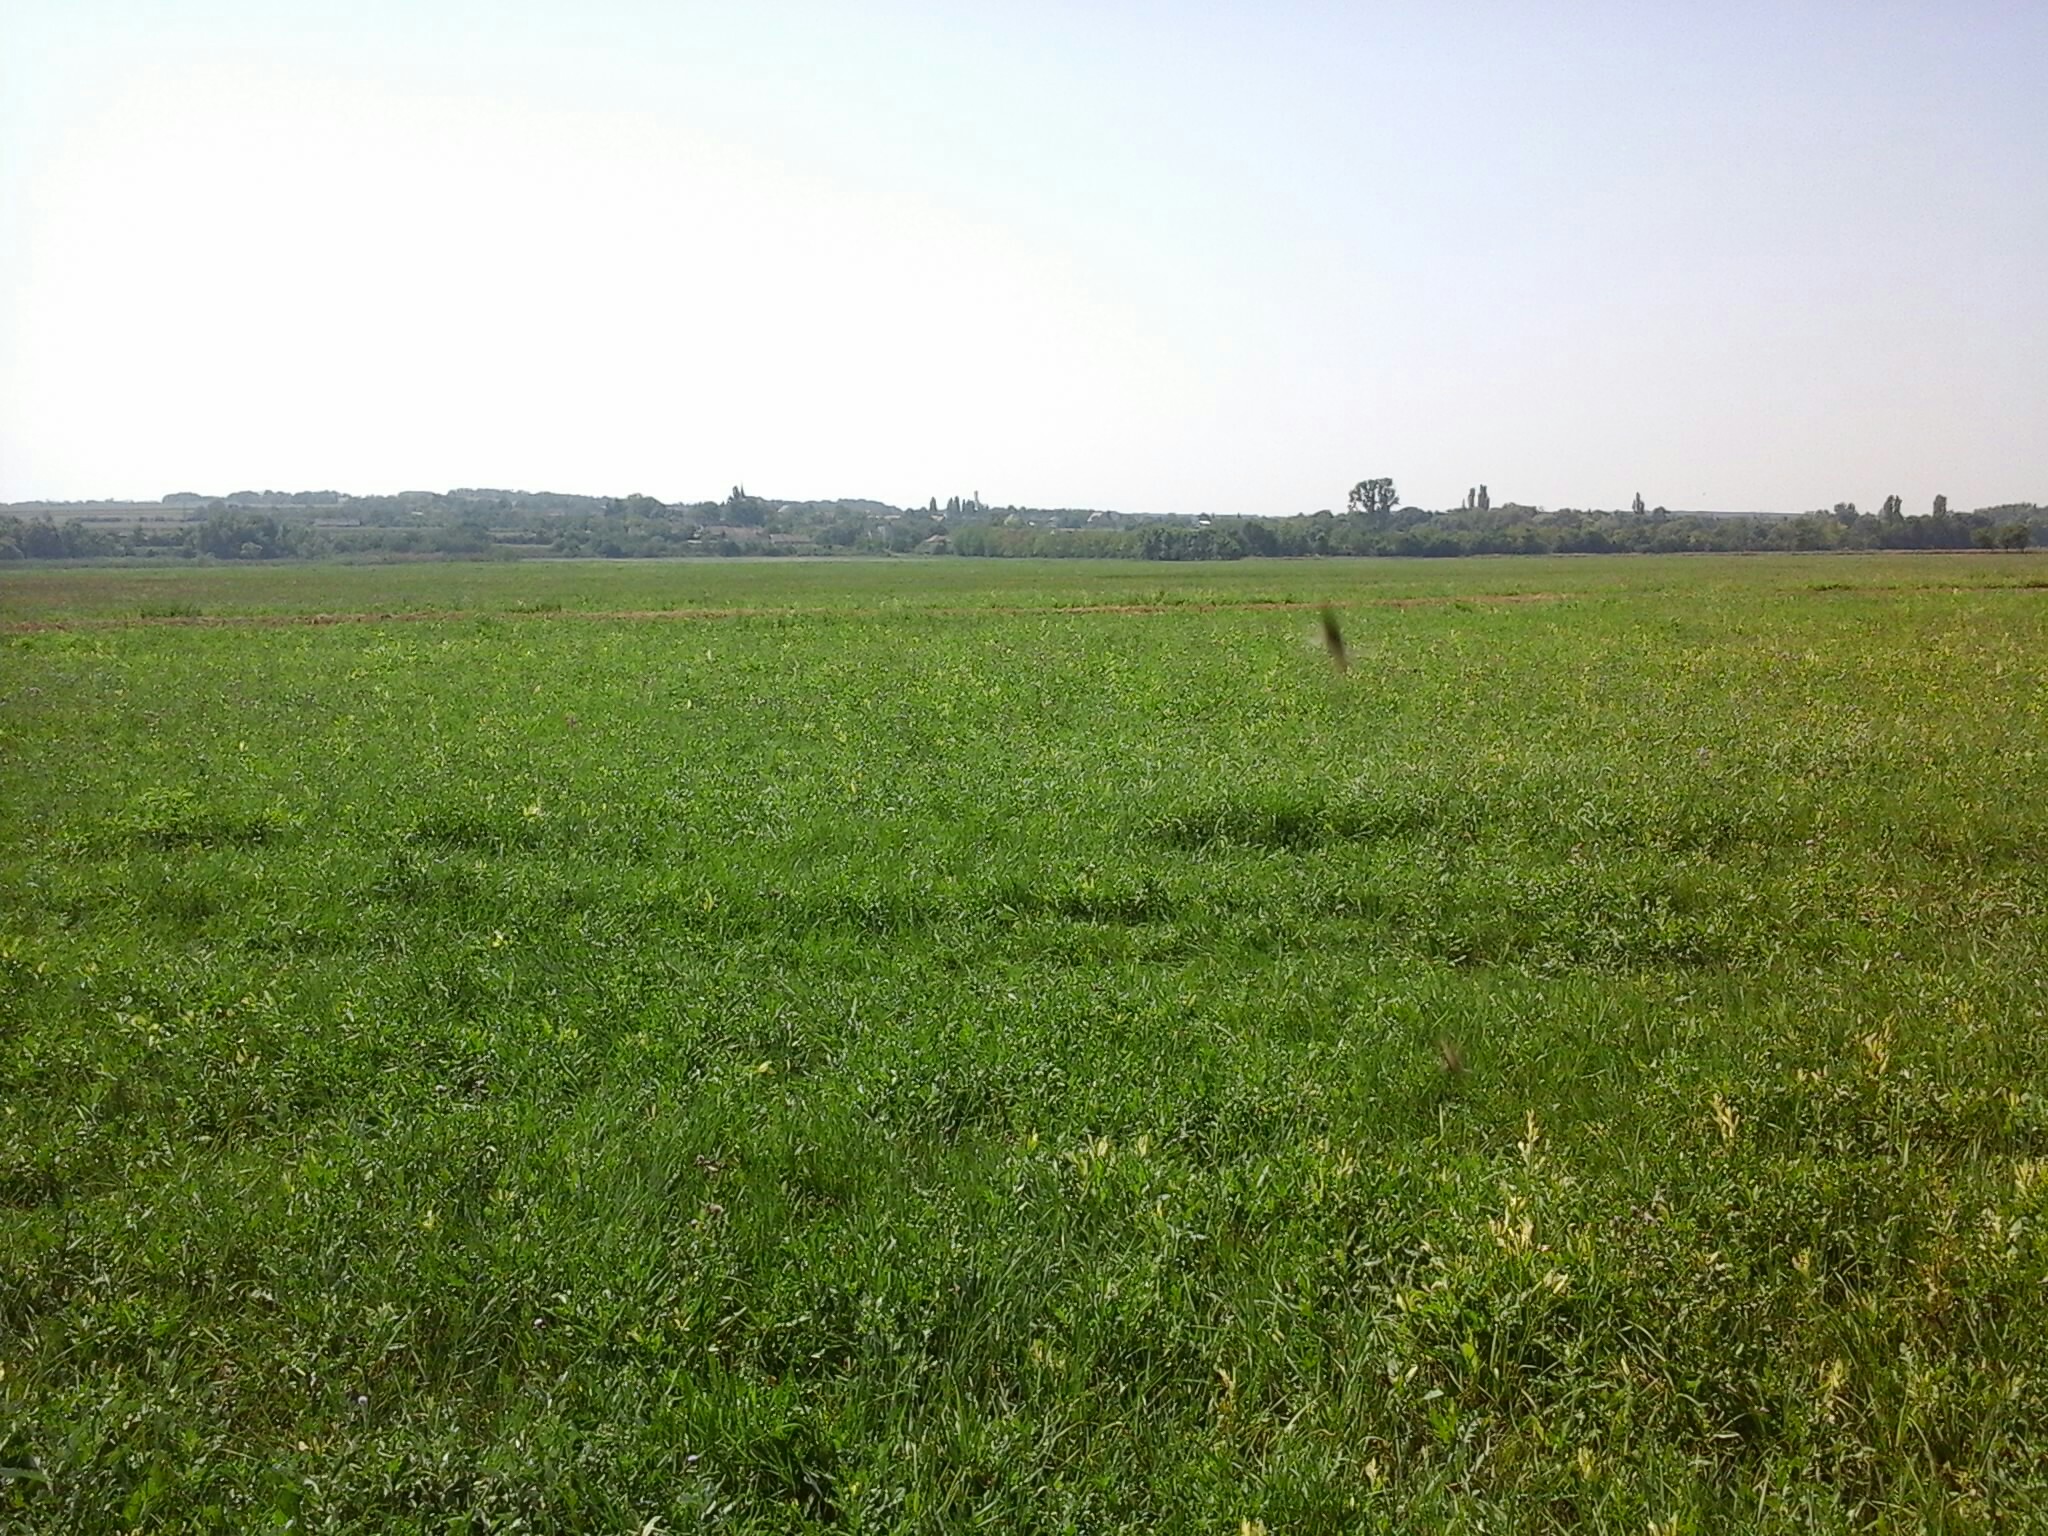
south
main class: Grassland
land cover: Grassland without tree/shrub cover
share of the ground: > 75 %
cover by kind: herbaceous plants 100 %
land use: Agriculture (excluding fallow land and kitchen gardens)
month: August
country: HU
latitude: 47.1697
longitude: 18.2833
